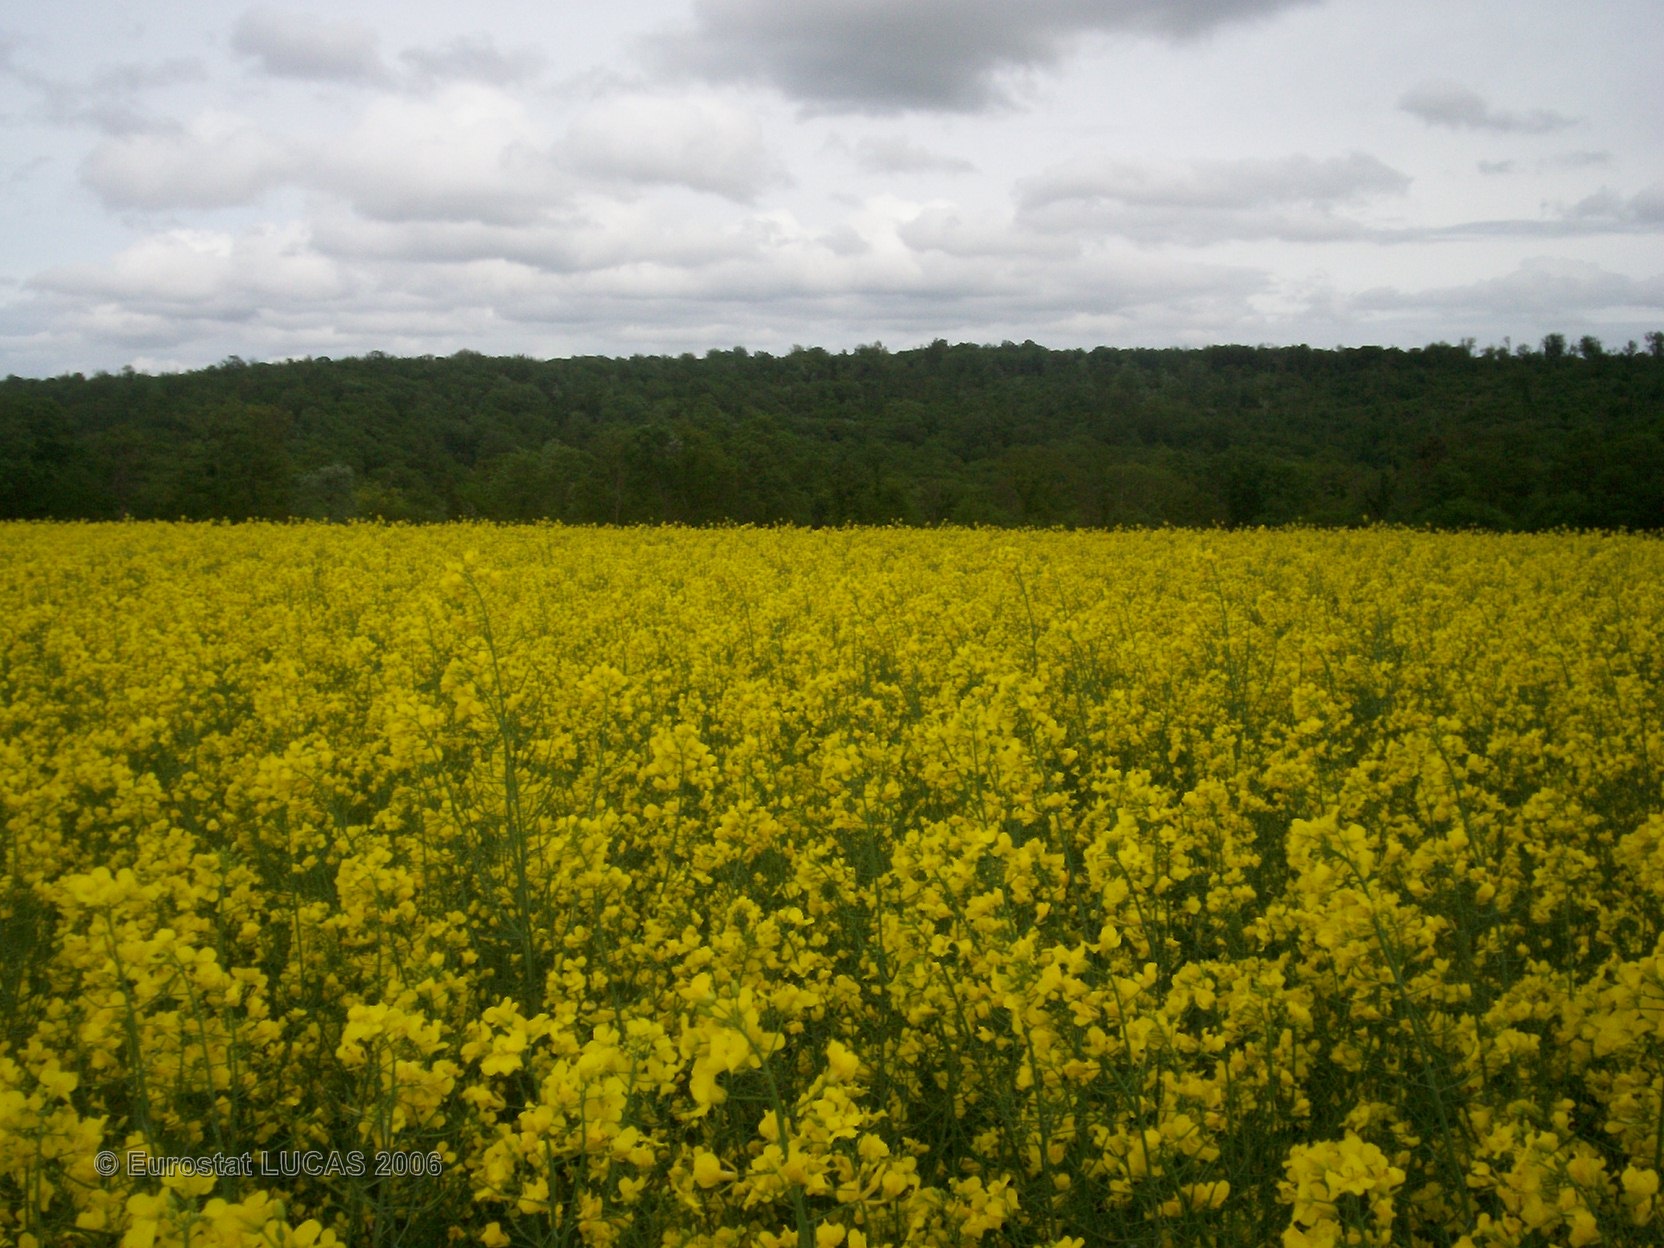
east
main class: Cropland
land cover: Rape and turnip rape
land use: Agriculture (excluding fallow land and kitchen gardens)
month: May
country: FR
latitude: 48.5824
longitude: 5.9738
